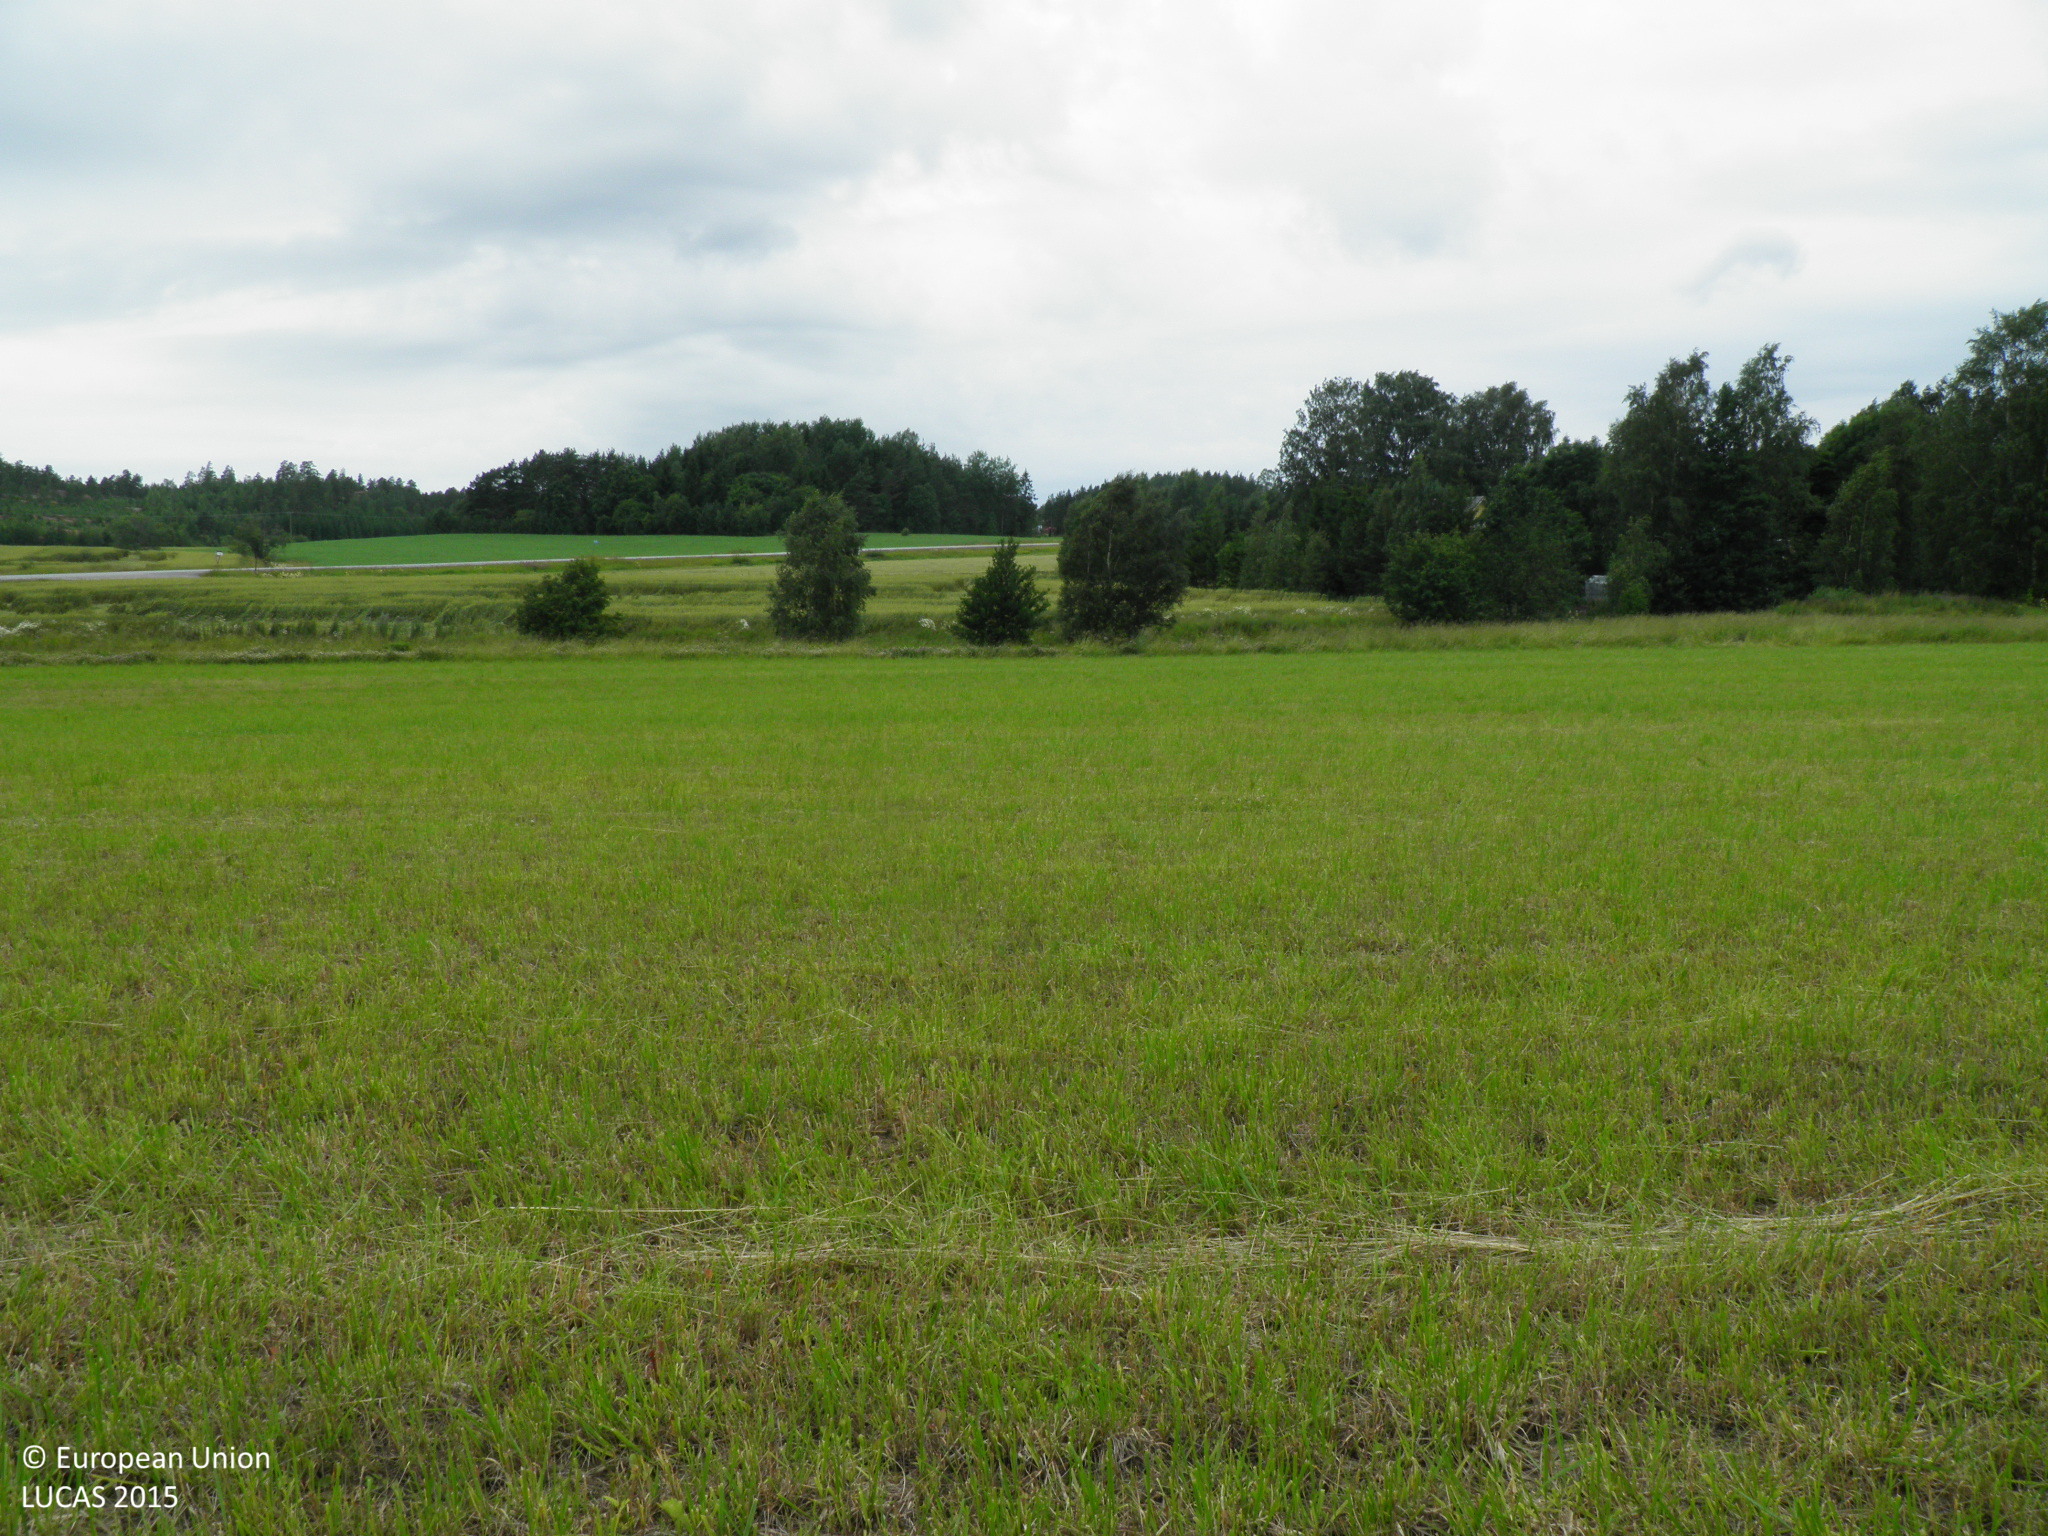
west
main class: Cropland
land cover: Temporary grasslands
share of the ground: > 75 %
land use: Agriculture (excluding fallow land and kitchen gardens)
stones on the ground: < 10 %
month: July
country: FI
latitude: 60.1868
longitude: 22.7159
